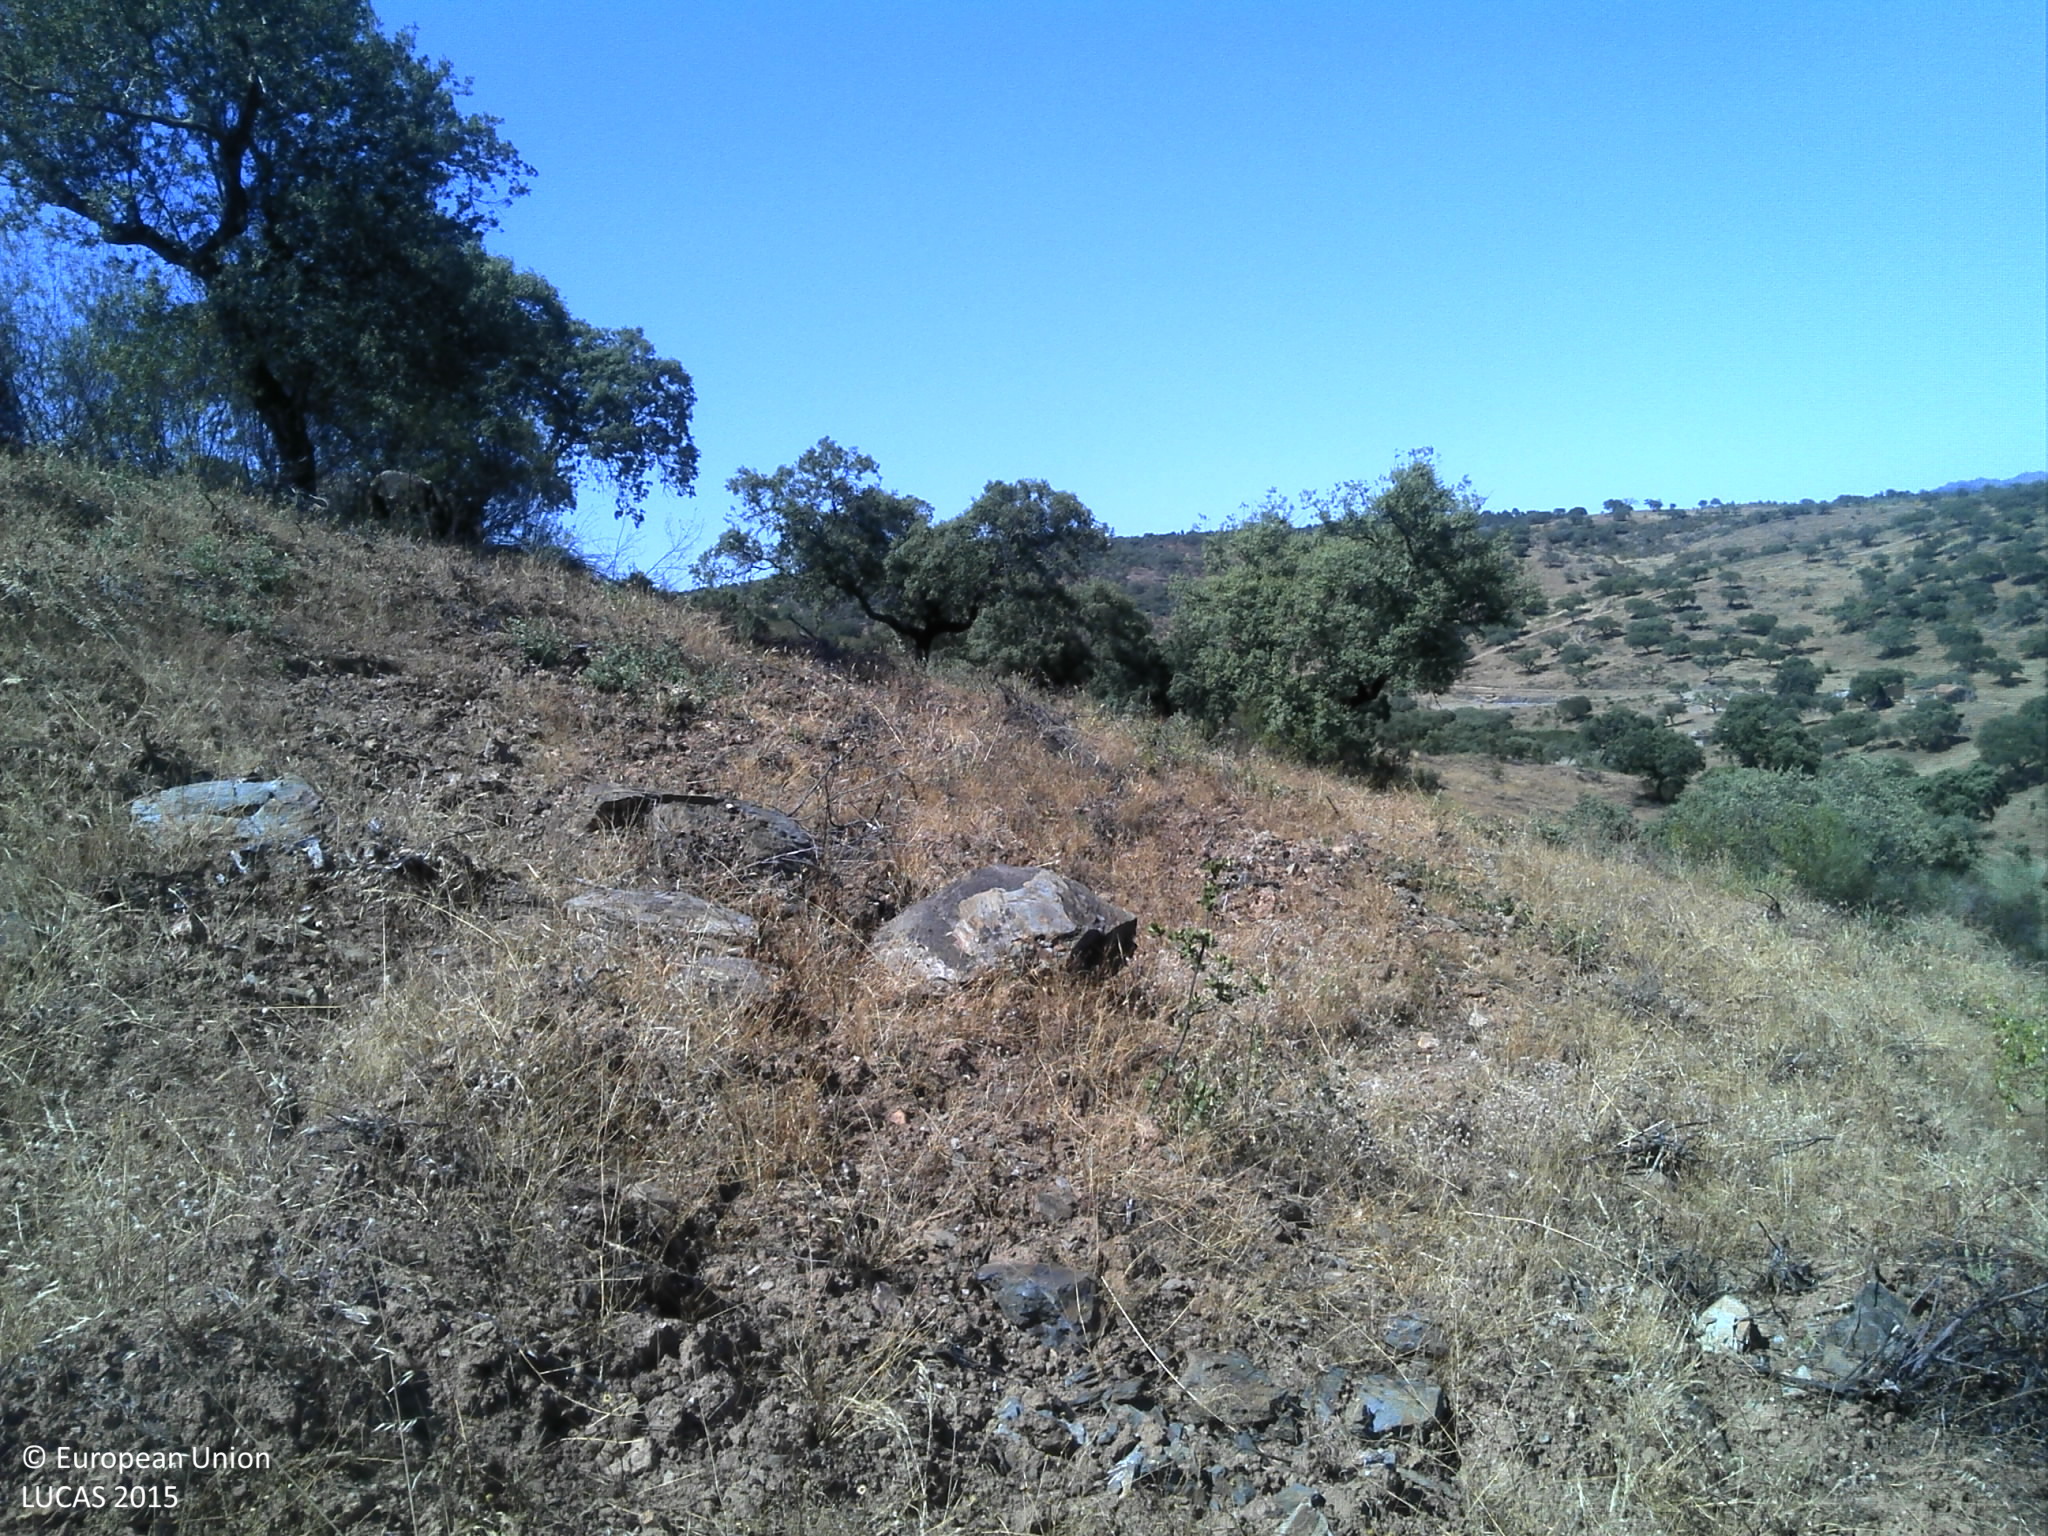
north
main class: Grassland
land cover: Grassland with sparse tree/shrub cover
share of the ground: 25 - 50 %
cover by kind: herbaceous plants 40 %, unconsolidated bare surface 40 %, broadleaved forest trees 5 %, shrubs 5 %
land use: Agriculture (excluding fallow land and kitchen gardens)
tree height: < 5 m
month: June
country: PT
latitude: 39.9889
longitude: -7.2054
